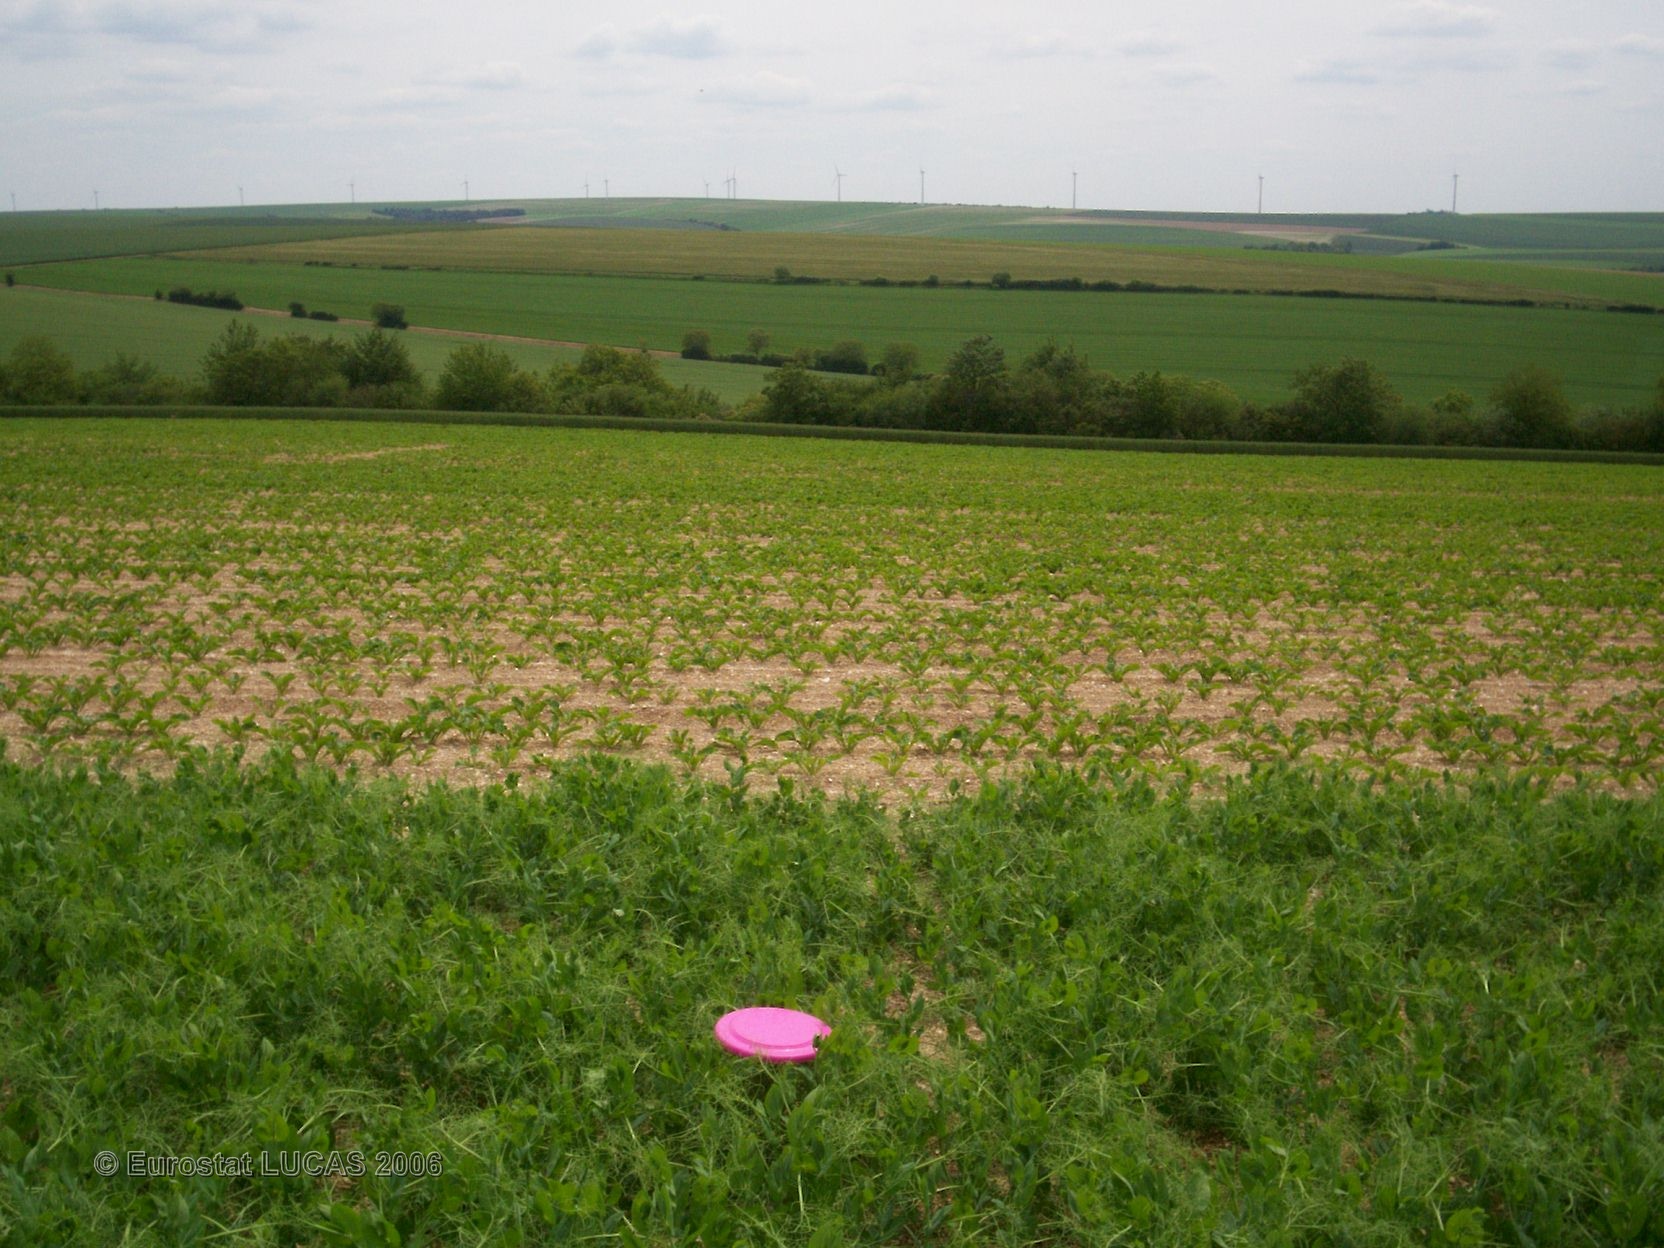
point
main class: Cropland
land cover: Dry pulses
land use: Agriculture (excluding fallow land and kitchen gardens)
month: June
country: FR
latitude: 48.8493
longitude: 4.6142
